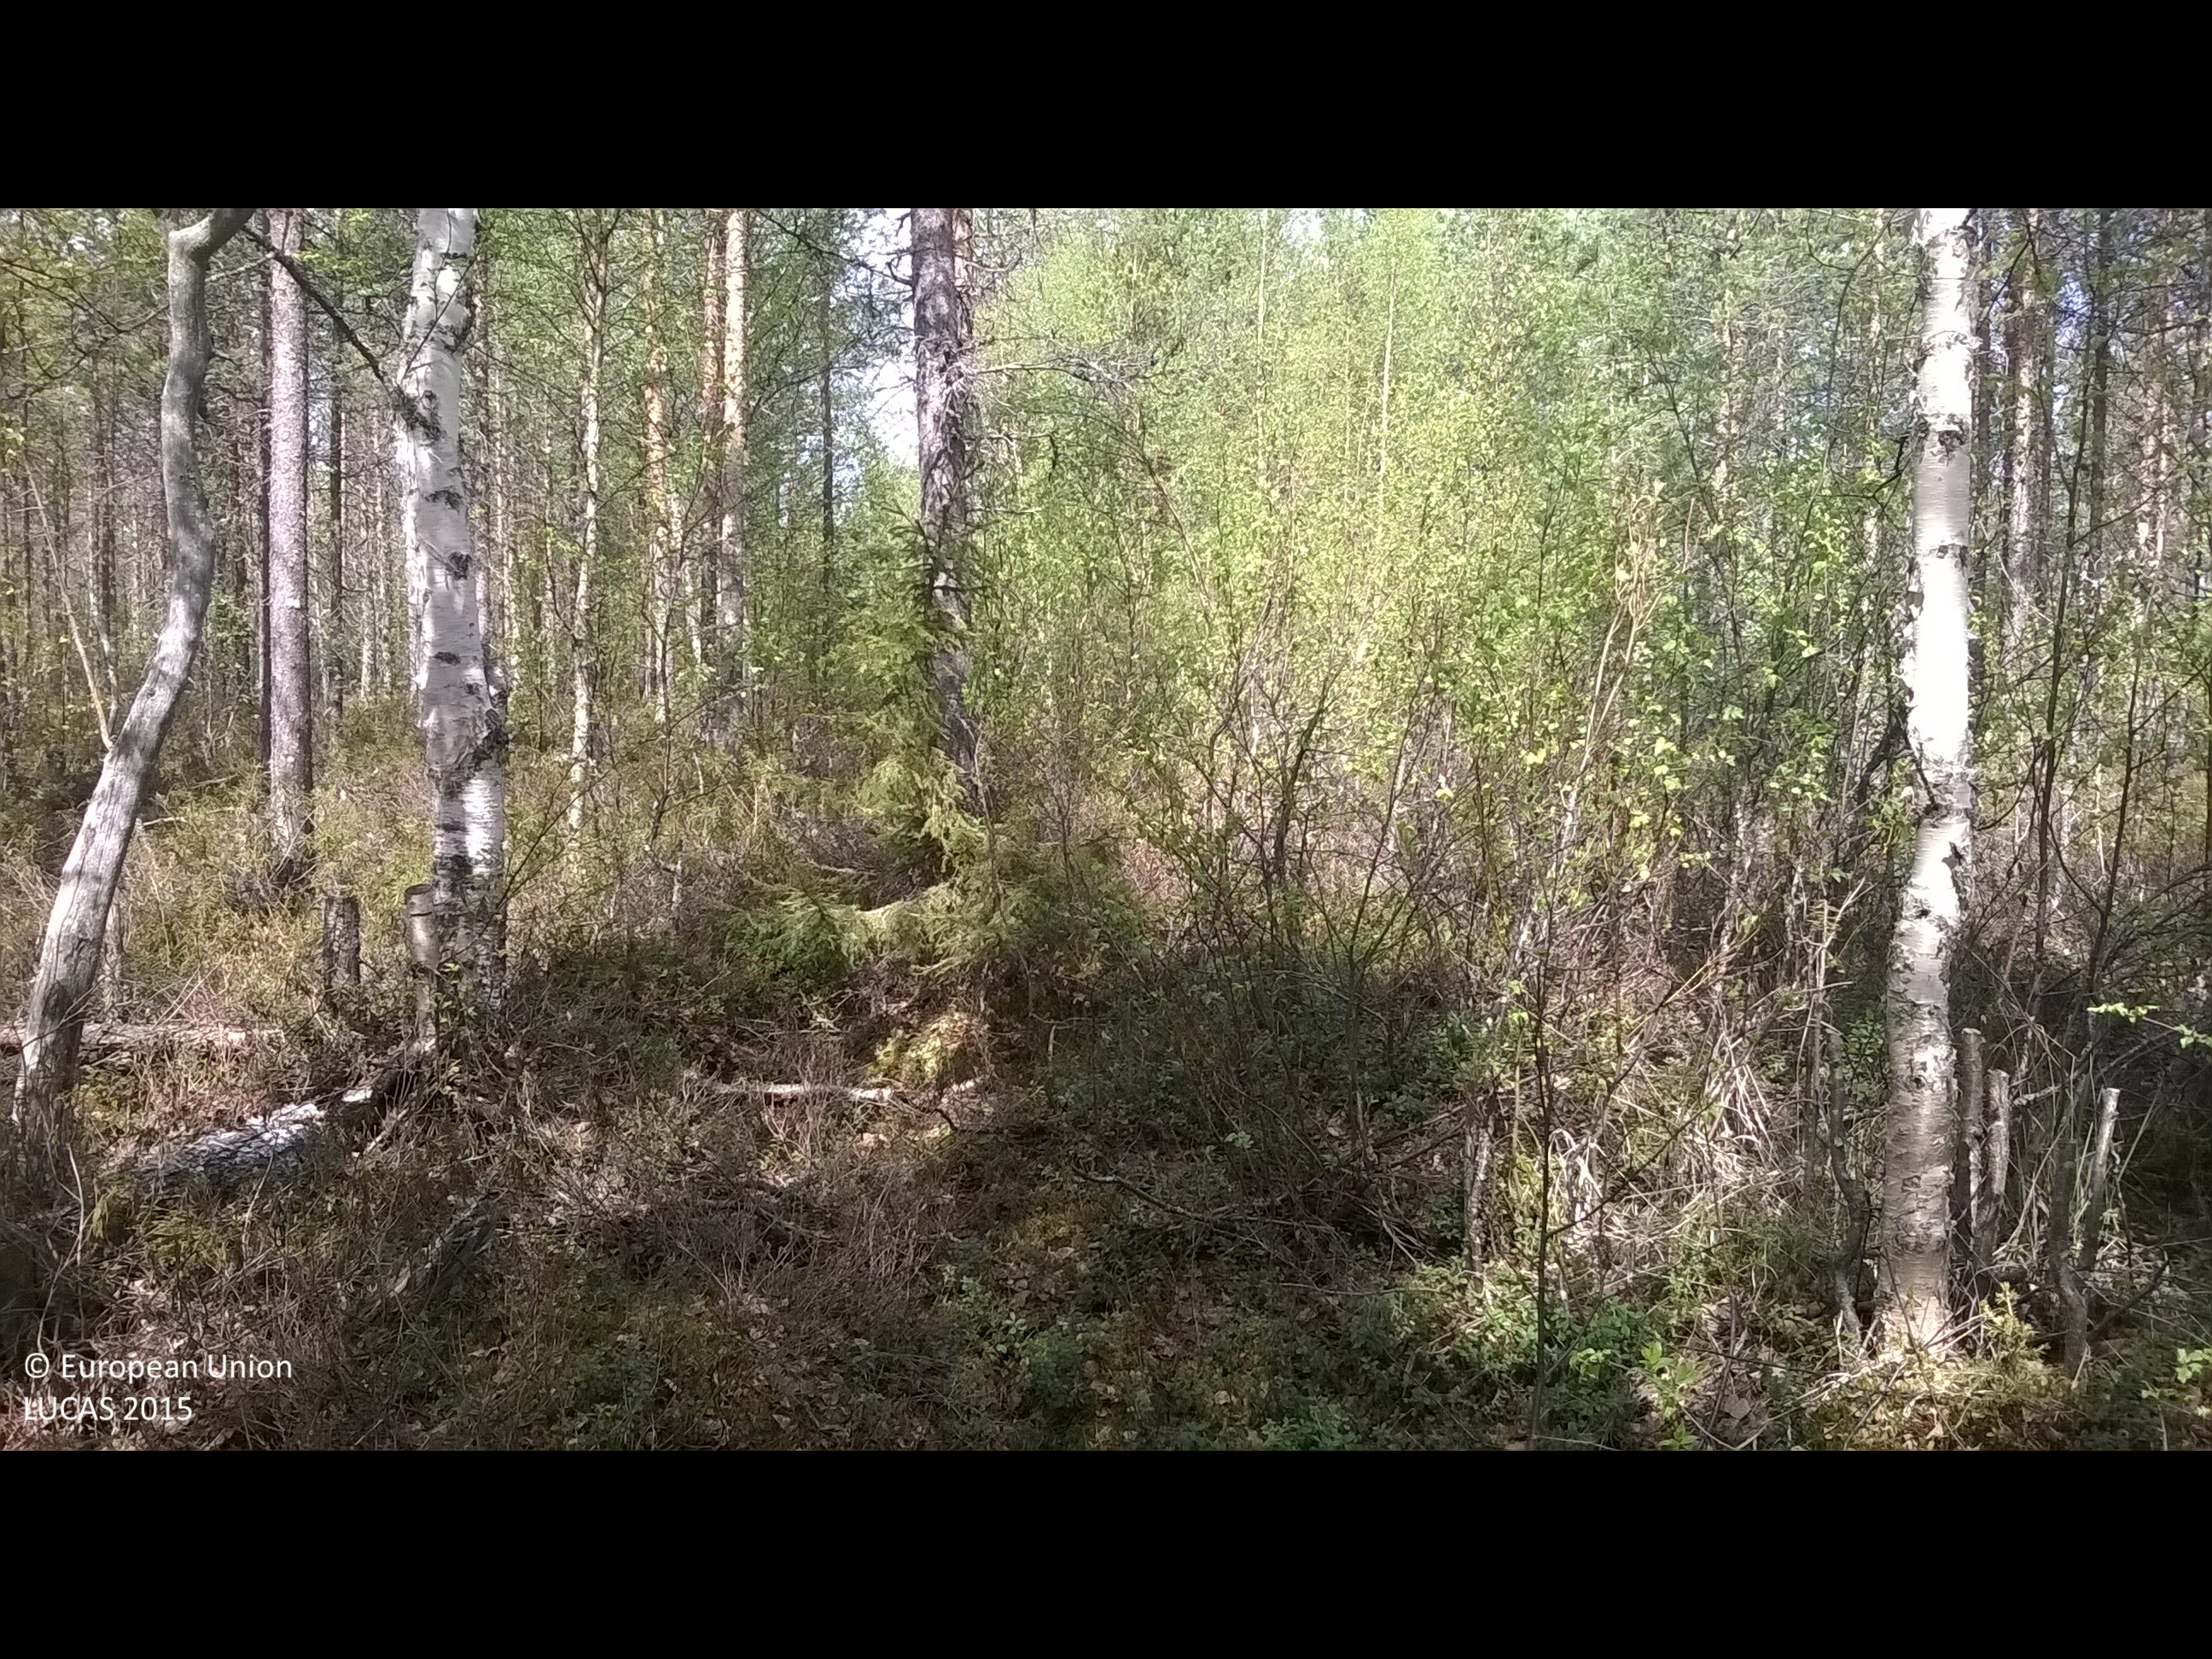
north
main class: Woodland
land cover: Pine dominated mixed woodland
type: boreal forest
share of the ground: > 75 %
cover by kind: broadleaved forest trees 60 %, coniferous forest trees 35 %, shrubs 5 %
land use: Forestry
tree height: > 5 m
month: June
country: FI
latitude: 66.5738
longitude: 26.4723
